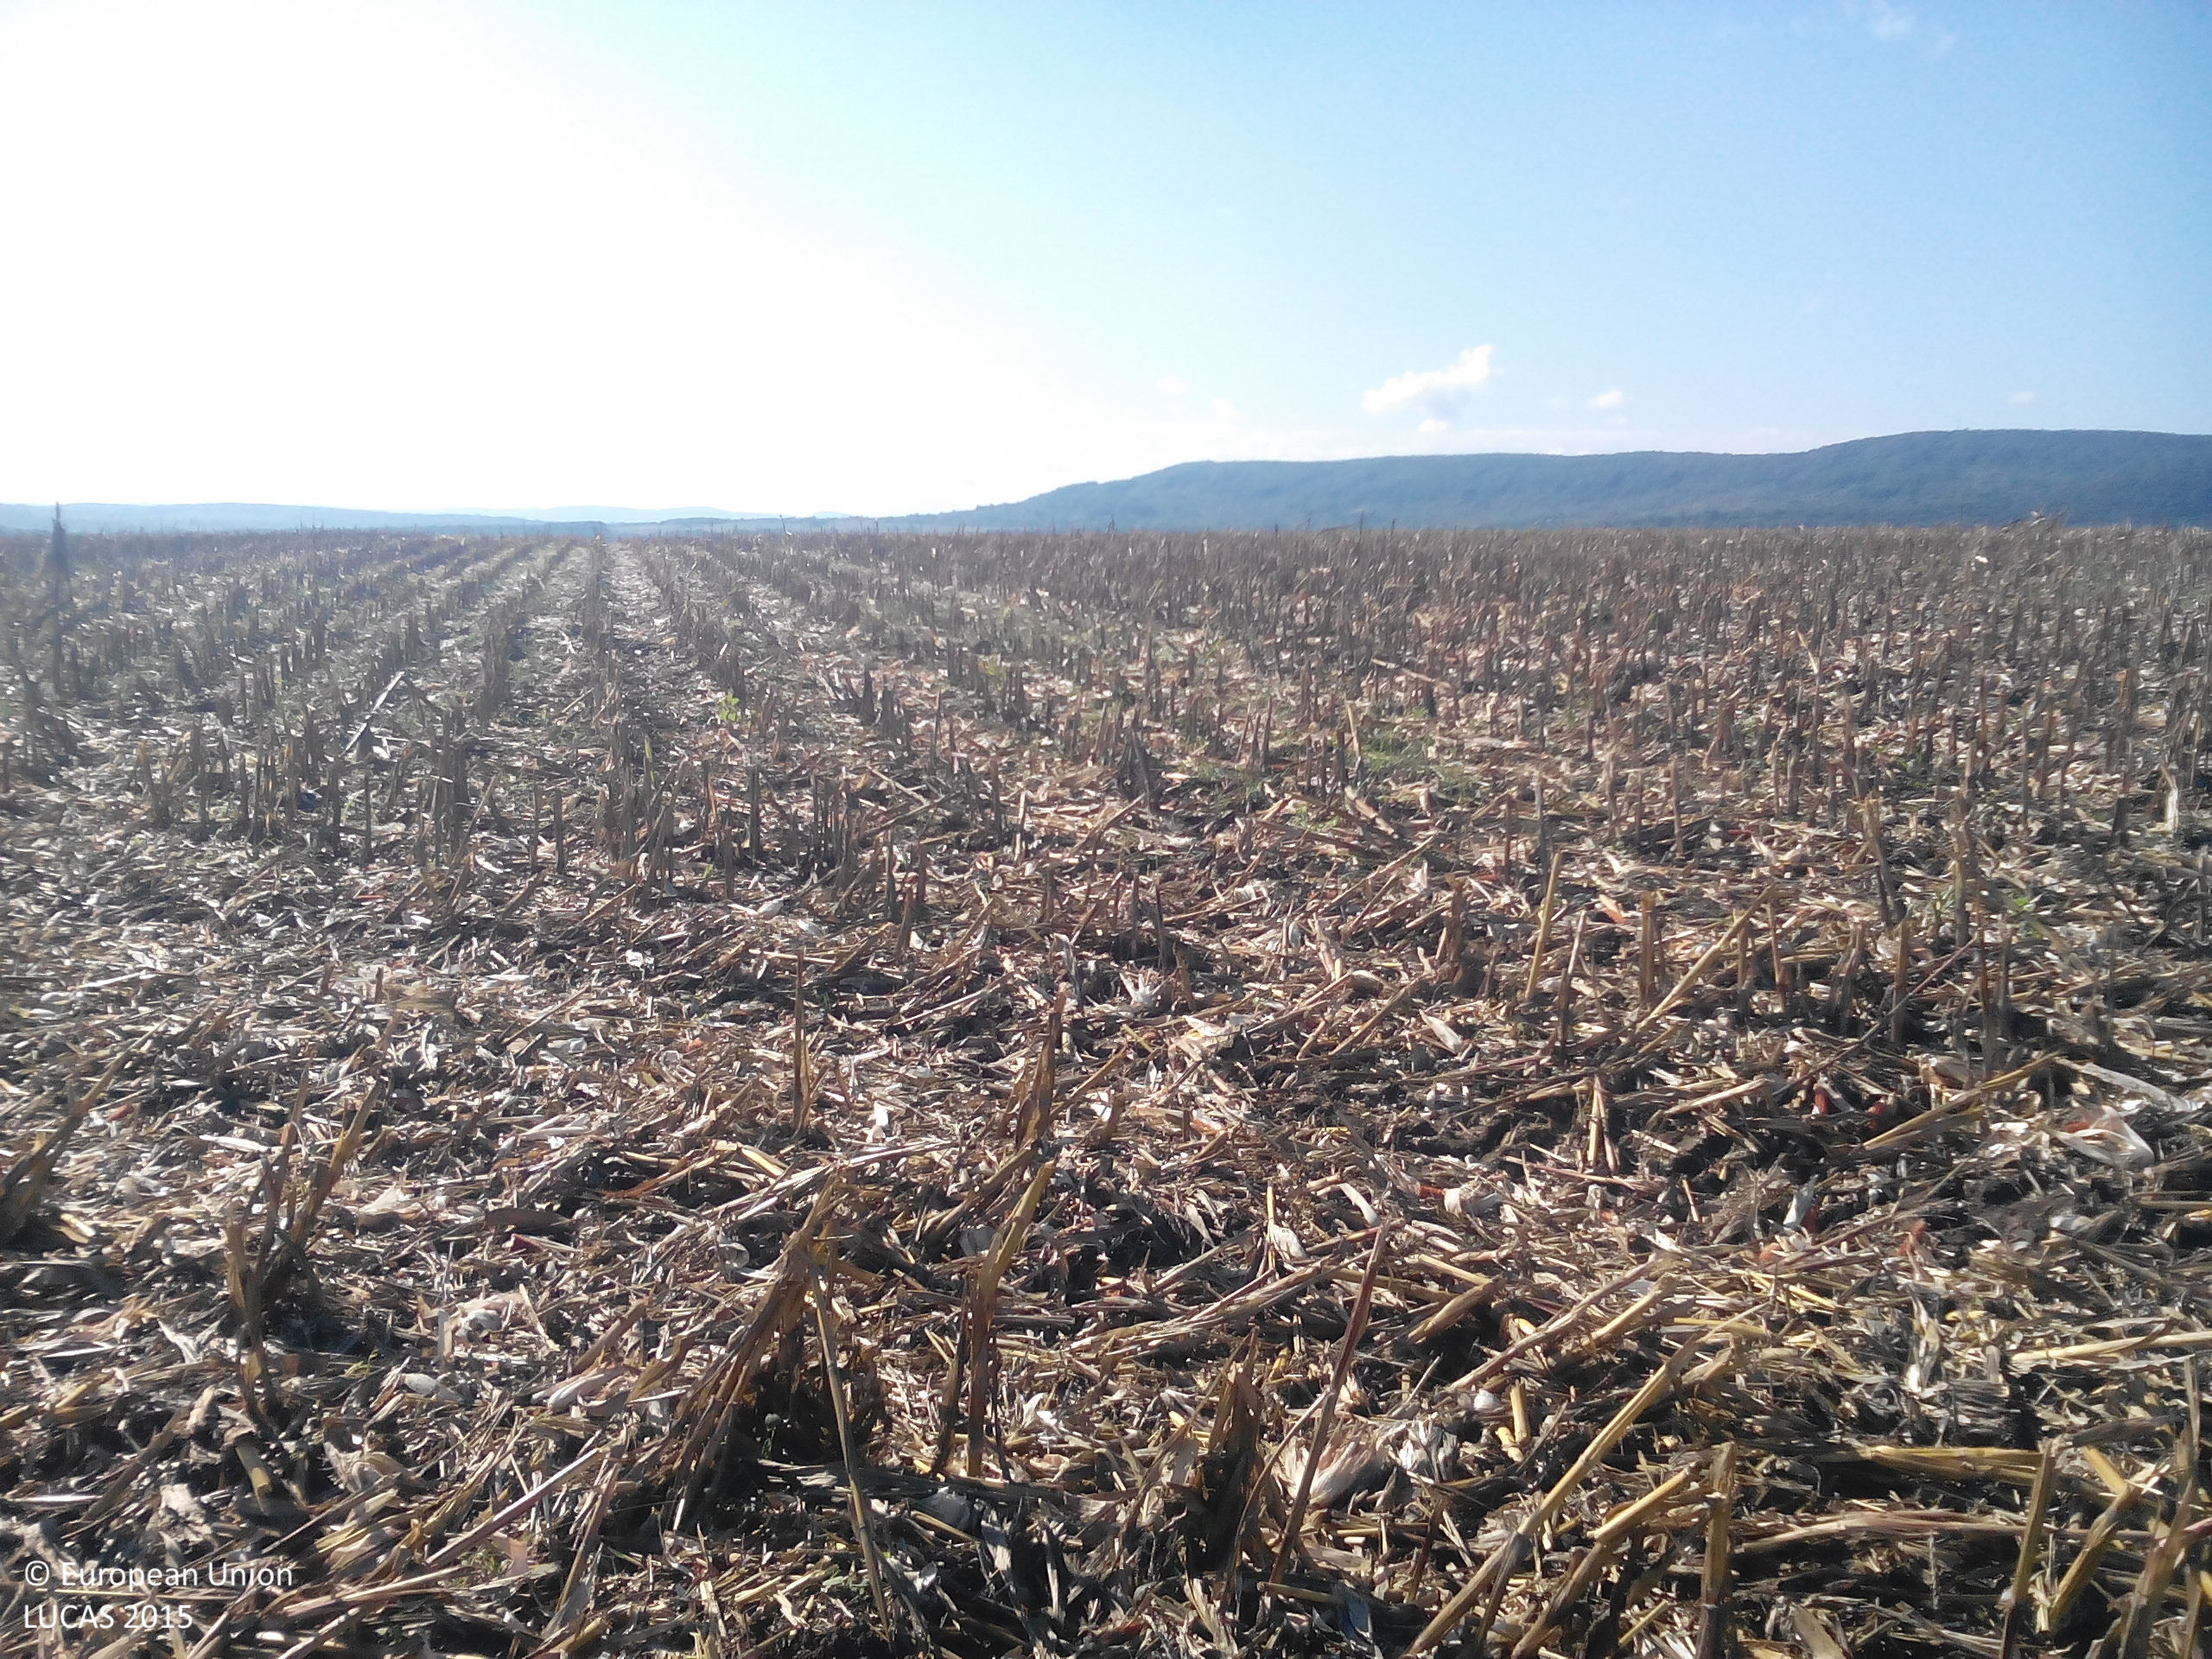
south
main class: Cropland
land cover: Maize
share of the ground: 10 - 25 %
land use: Agriculture (excluding fallow land and kitchen gardens)
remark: Harvested field
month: October
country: BG
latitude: 43.3918
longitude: 23.7636
